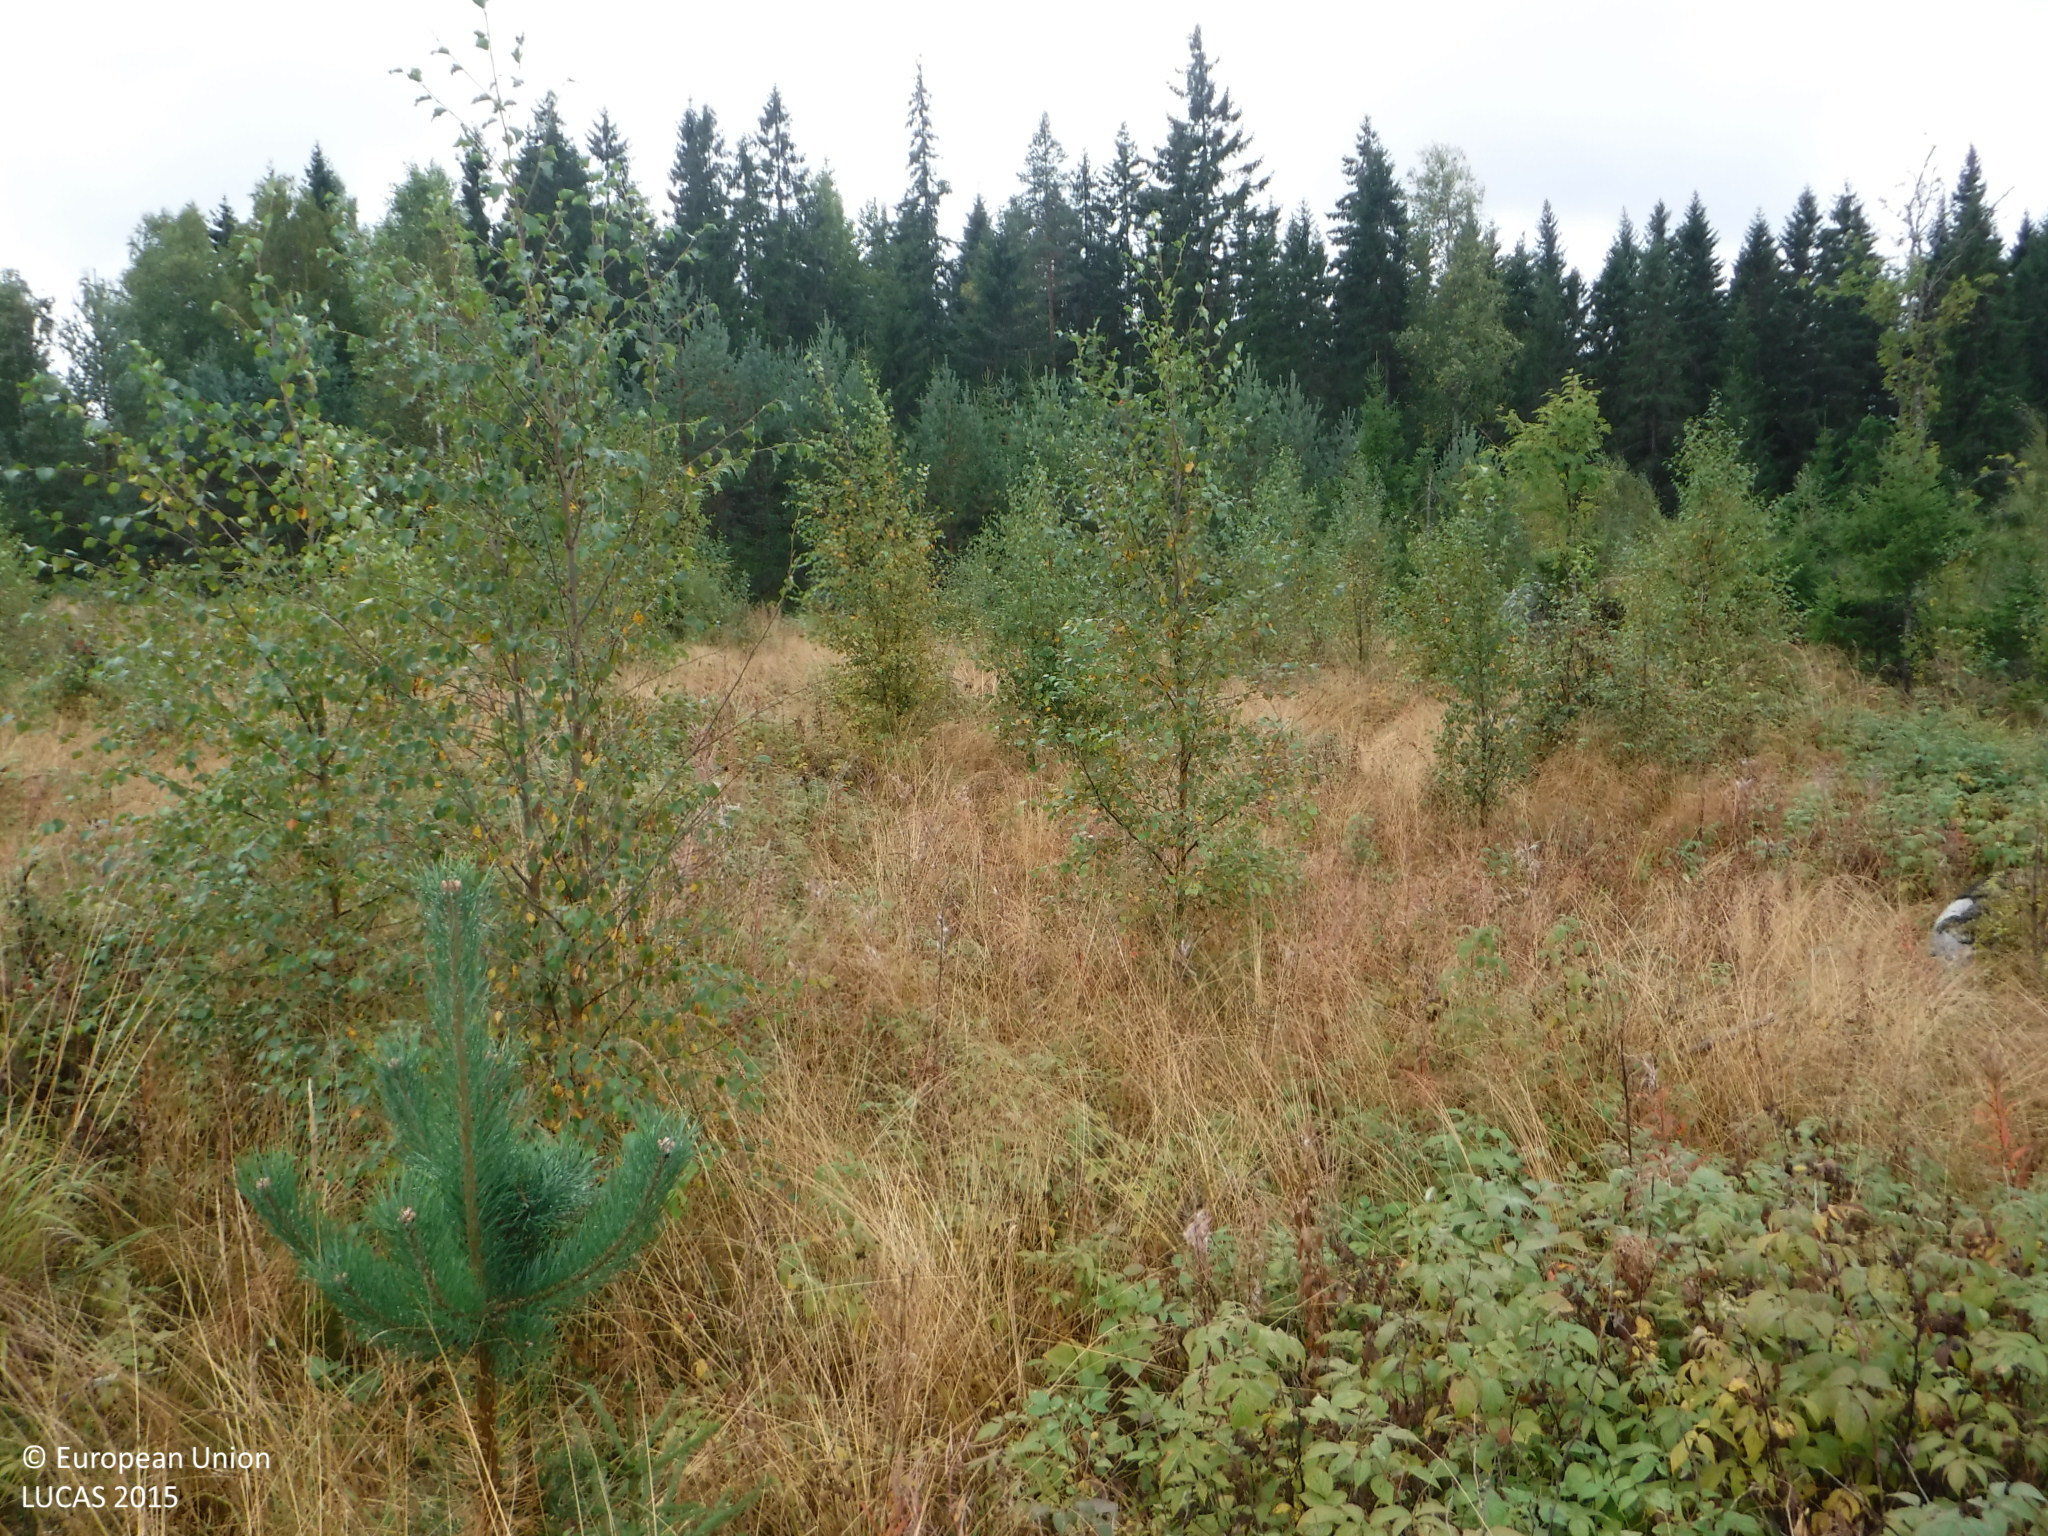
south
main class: Shrubland
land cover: Shrubland with sparse tree cover
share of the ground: 50 - 75 %
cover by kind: herbaceous plants 50 %, shrubs 45 %, broadleaved forest trees 5 %
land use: Forestry
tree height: < 5 m
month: September
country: FI
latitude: 61.3198
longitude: 23.1310
